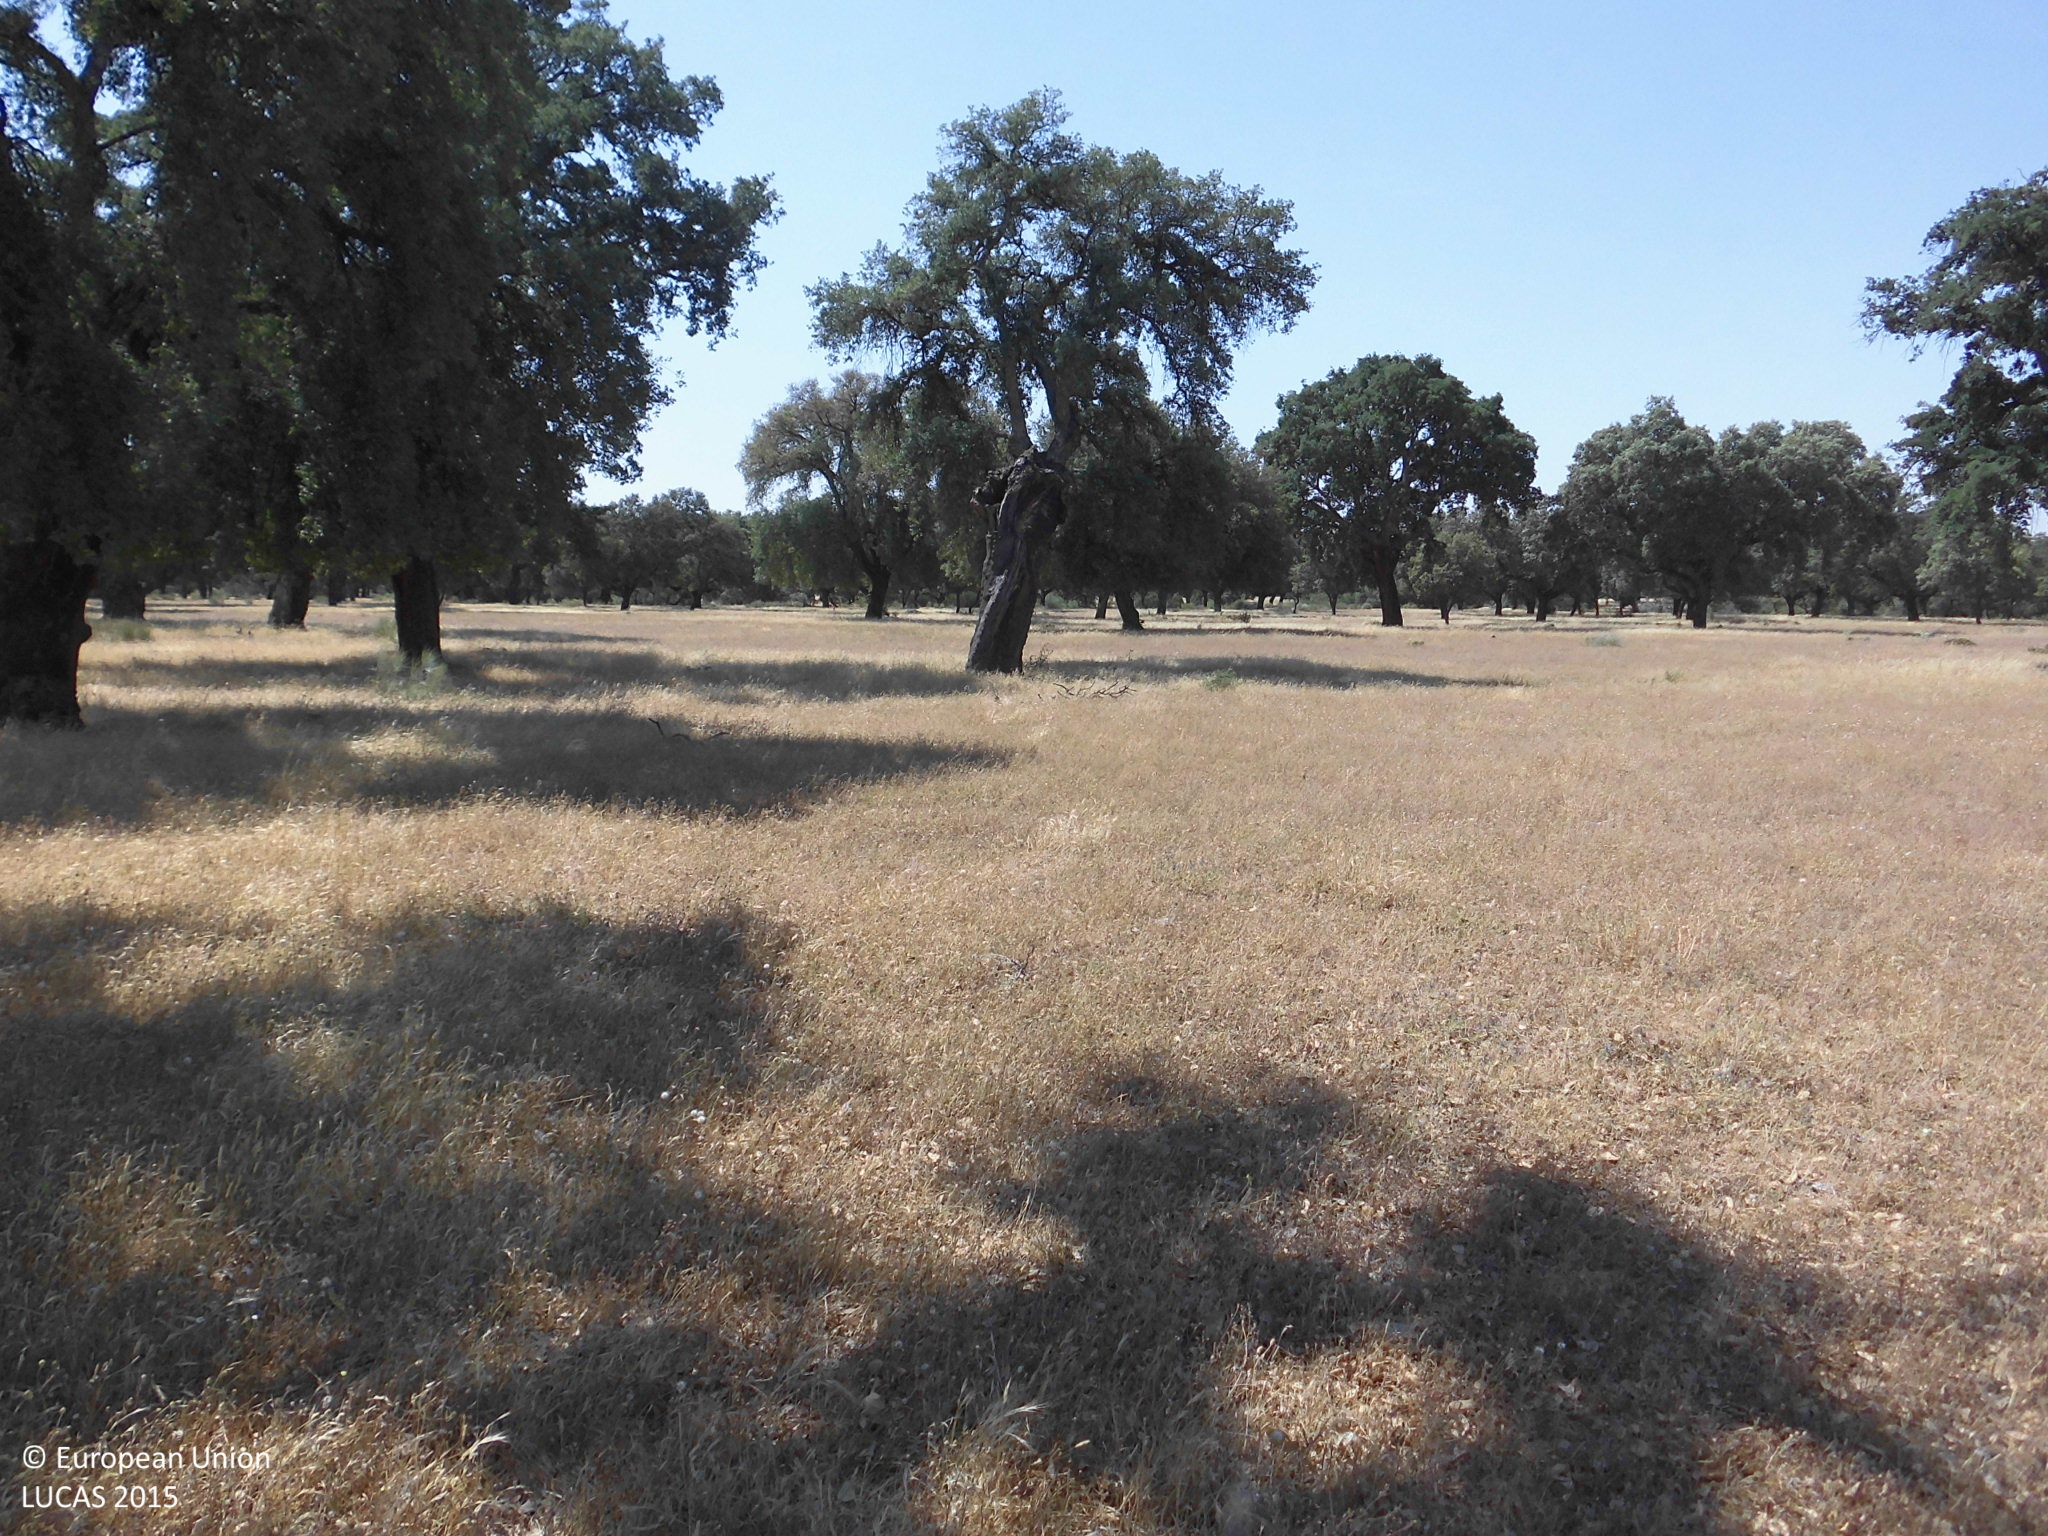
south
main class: Woodland
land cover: Broadleaved woodland
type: broadleaved evergreen forest
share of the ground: 25 - 50 %
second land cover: Grassland without tree/shrub cover
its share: > 75 %
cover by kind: herbaceous plants 75 %, broadleaved forest trees 25 %
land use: Forestry
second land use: Agriculture (excluding fallow land and kitchen gardens)
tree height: > 5 m
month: June
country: ES
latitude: 39.9364
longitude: -5.4465
